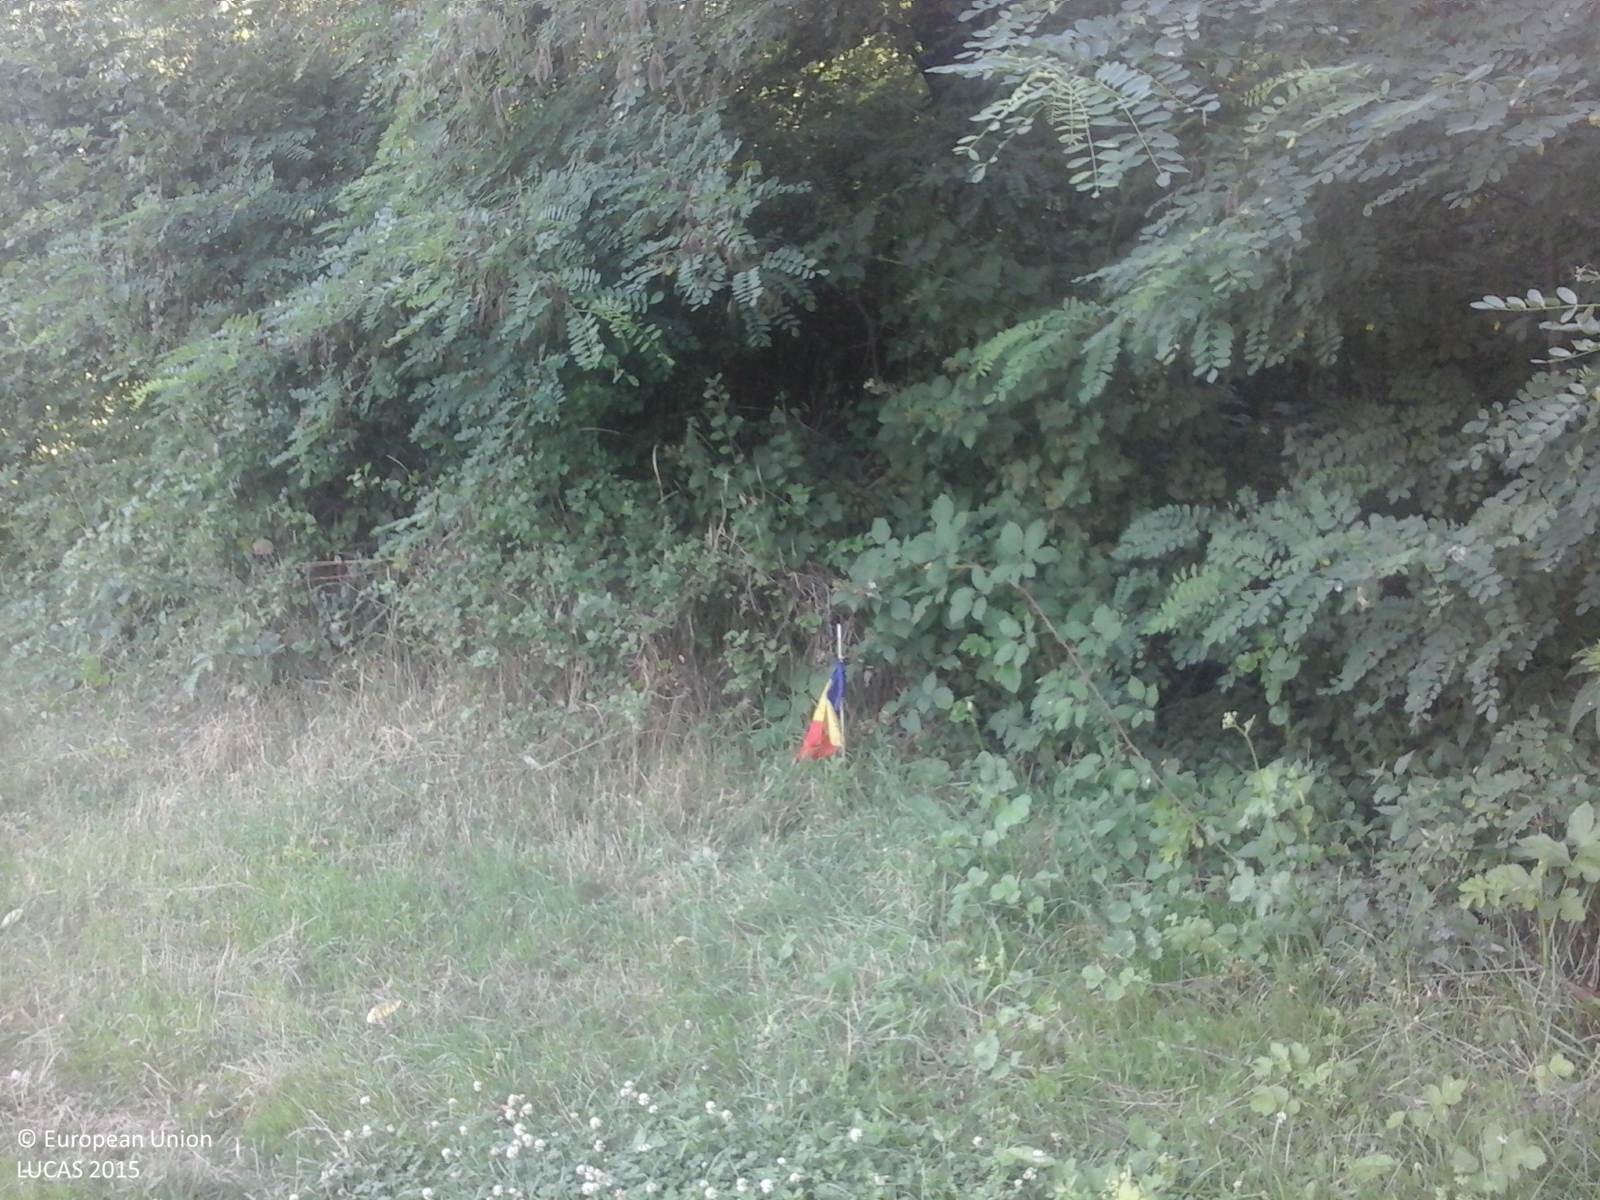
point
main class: Woodland
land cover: Broadleaved woodland
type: exotic forest
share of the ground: > 75 %
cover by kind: broadleaved forest trees 100 %
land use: Forestry
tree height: > 5 m
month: July
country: RO
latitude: 45.0371
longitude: 24.4313
